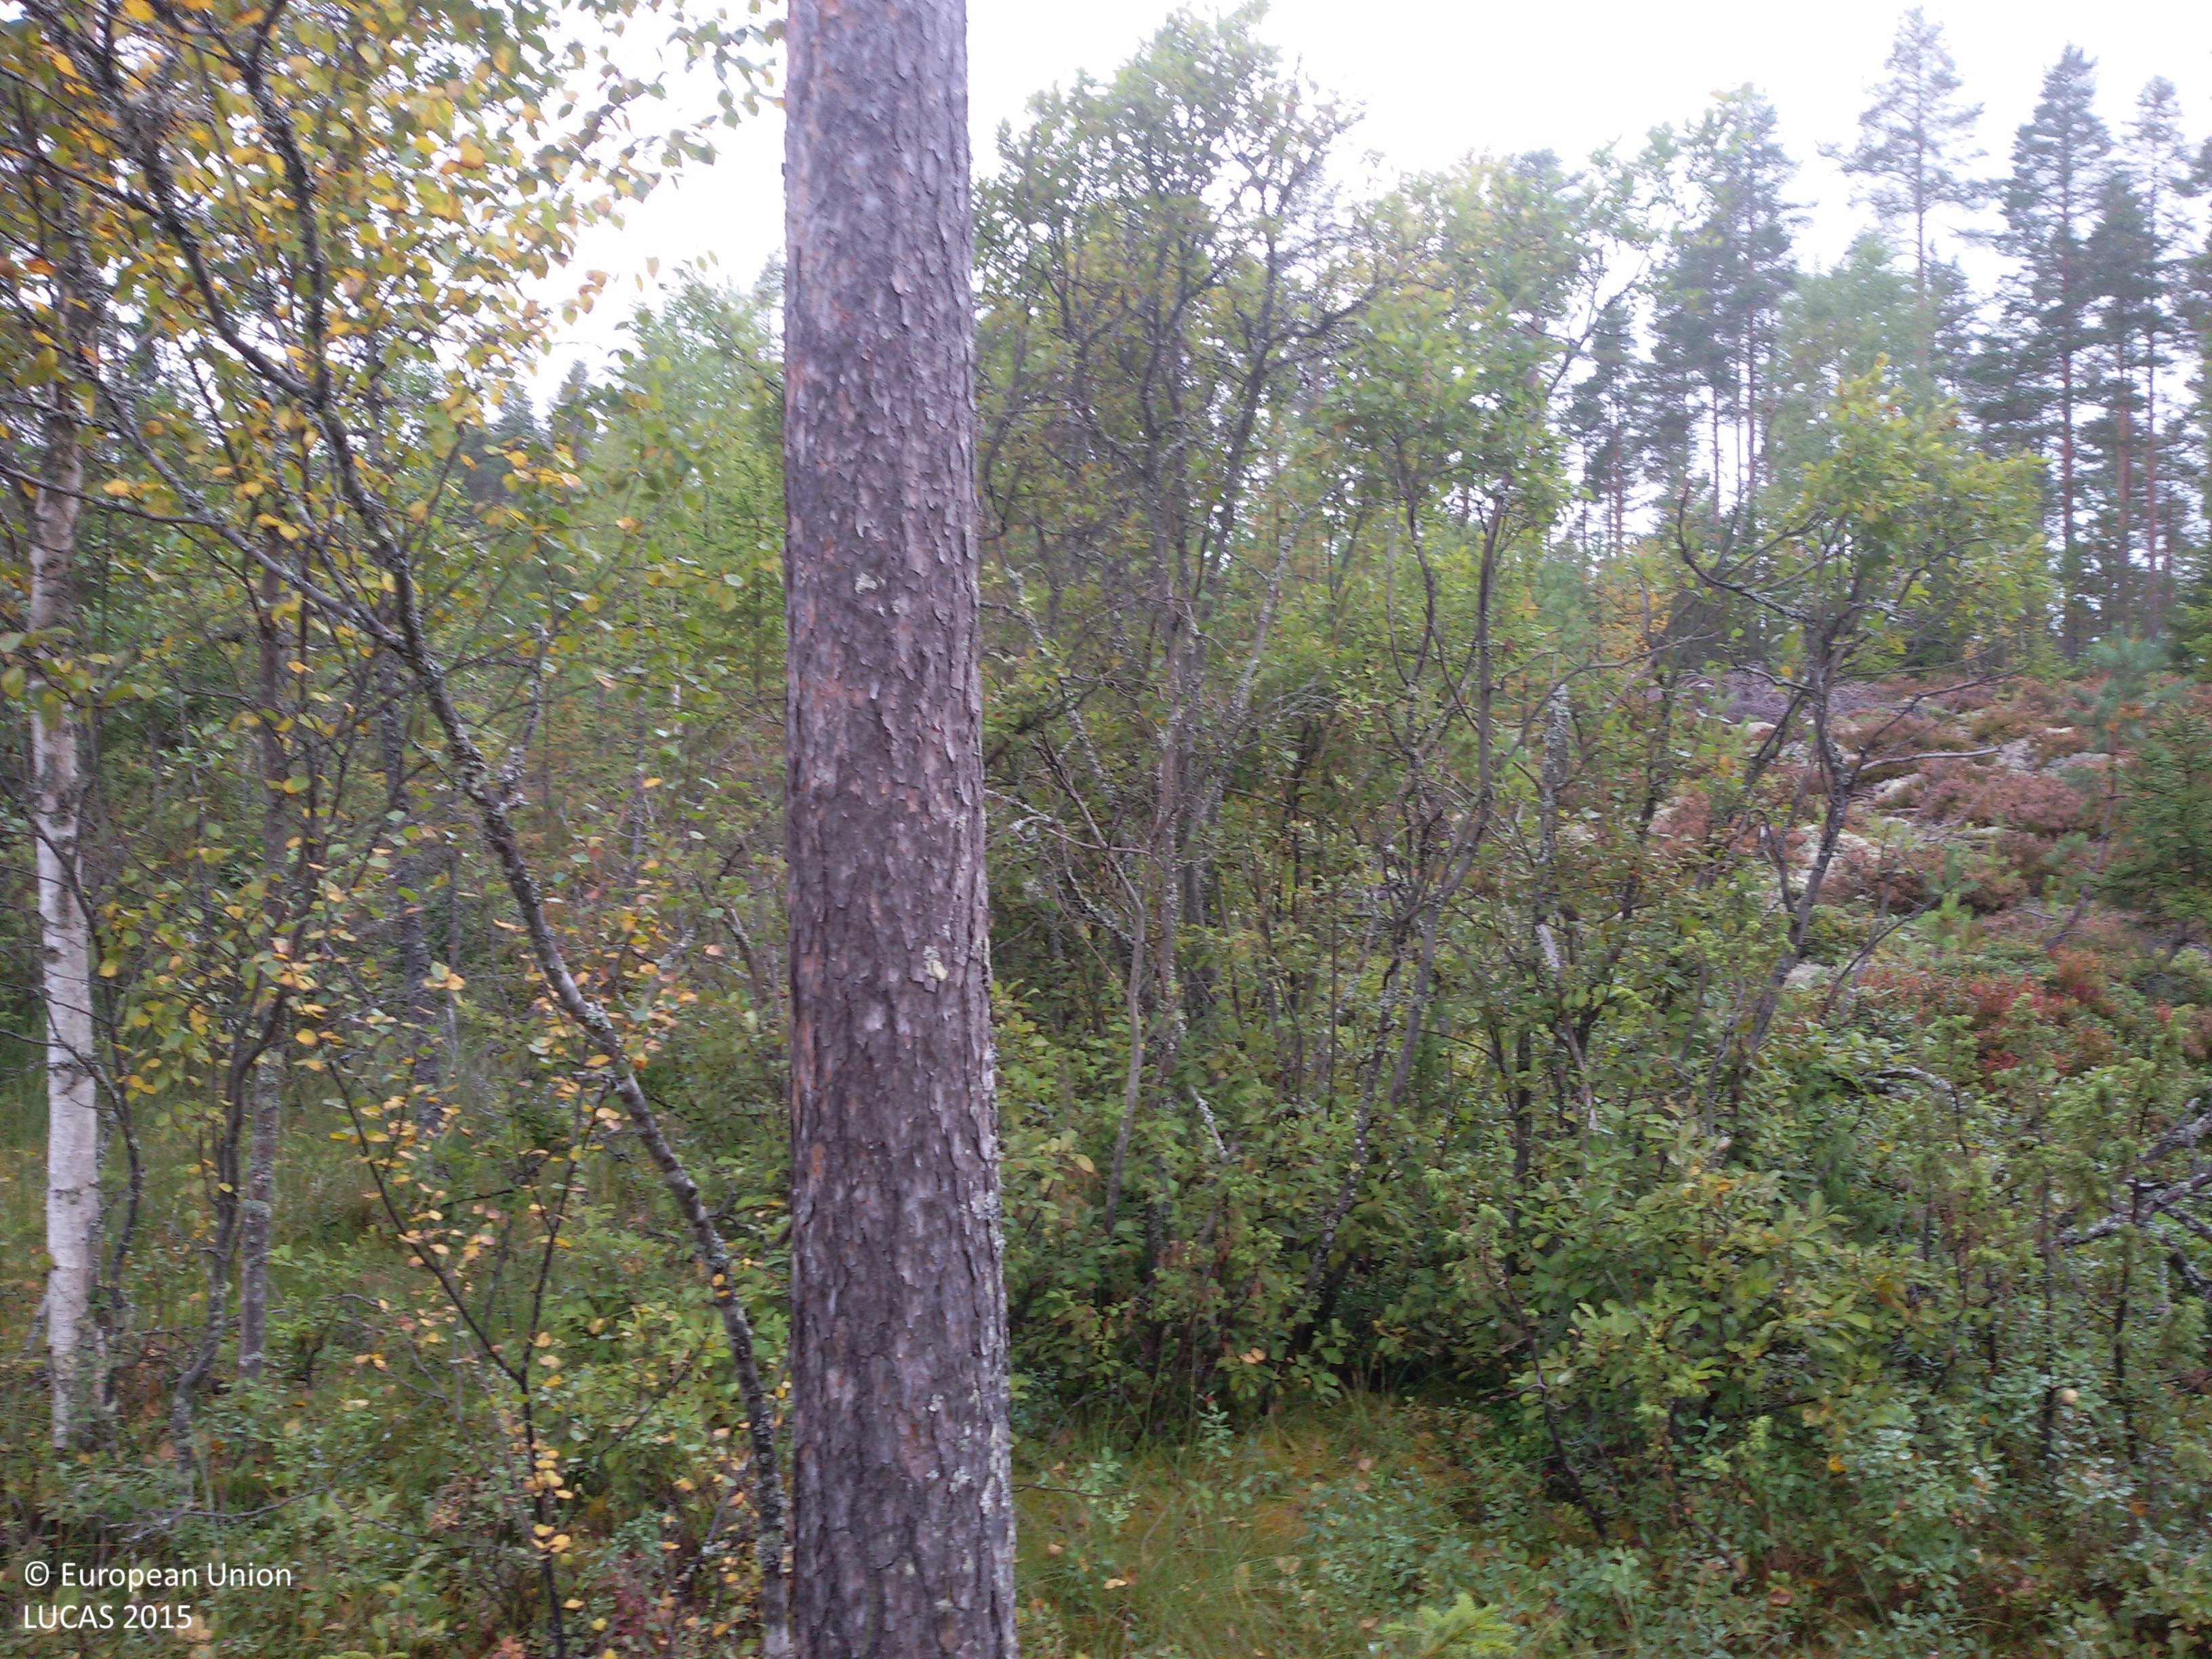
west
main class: Woodland
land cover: Pine dominated coniferous woodland
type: boreal forest
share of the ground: 50 - 75 %
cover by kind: coniferous forest trees 50 %, shrubs 25 %, lichens and mosses 25 %
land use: Forestry
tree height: > 5 m
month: September
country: SE
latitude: 61.0349
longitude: 14.3000
